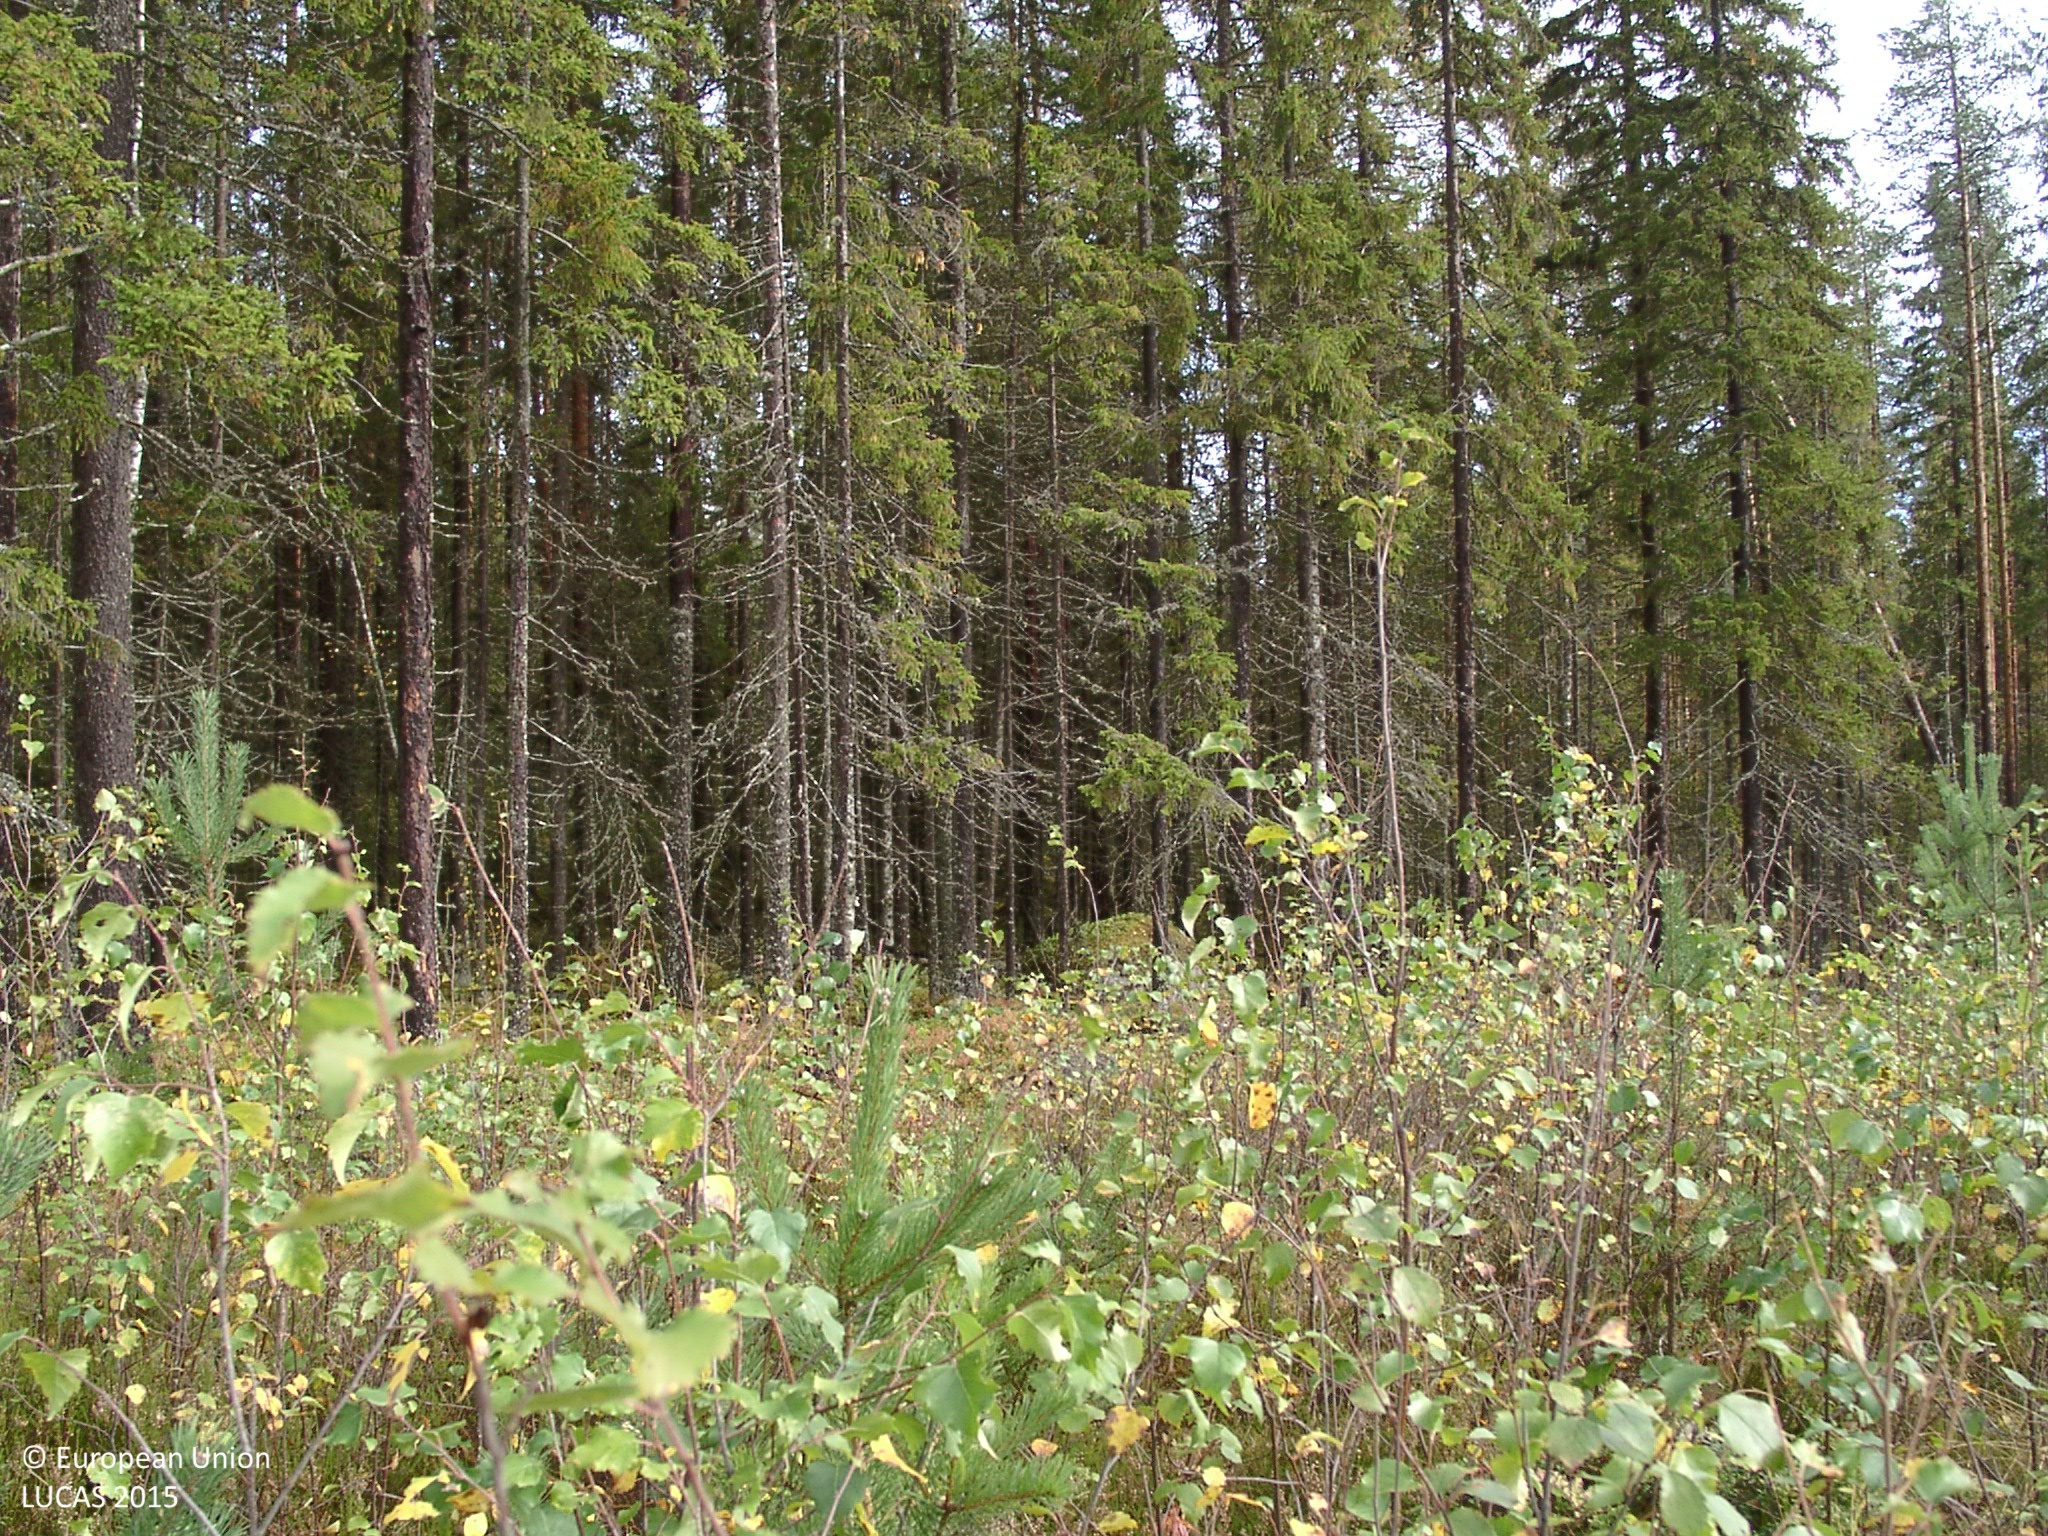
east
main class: Woodland
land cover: Pine dominated mixed woodland
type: boreal forest
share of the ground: 25 - 50 %
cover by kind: shrubs 50 %, broadleaved forest trees 20 %, coniferous forest trees 10 %, herbaceous plants 10 %, lichens and mosses 10 %
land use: Forestry
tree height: < 5 m
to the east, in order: Pine dominated mixed woodland; Shrubland without tree cover; Spruce dominated coniferous woodland; Other coniferous woodland; Tracks; Other coniferous woodland; Tracks; Other coniferous woodland; Tracks; Other coniferous woodland; Tracks; Other coniferous woodland; Ditches and canals; Other coniferous woodland; Tracks; Other coniferous woodland
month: September
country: FI
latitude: 62.7221
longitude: 25.7022
